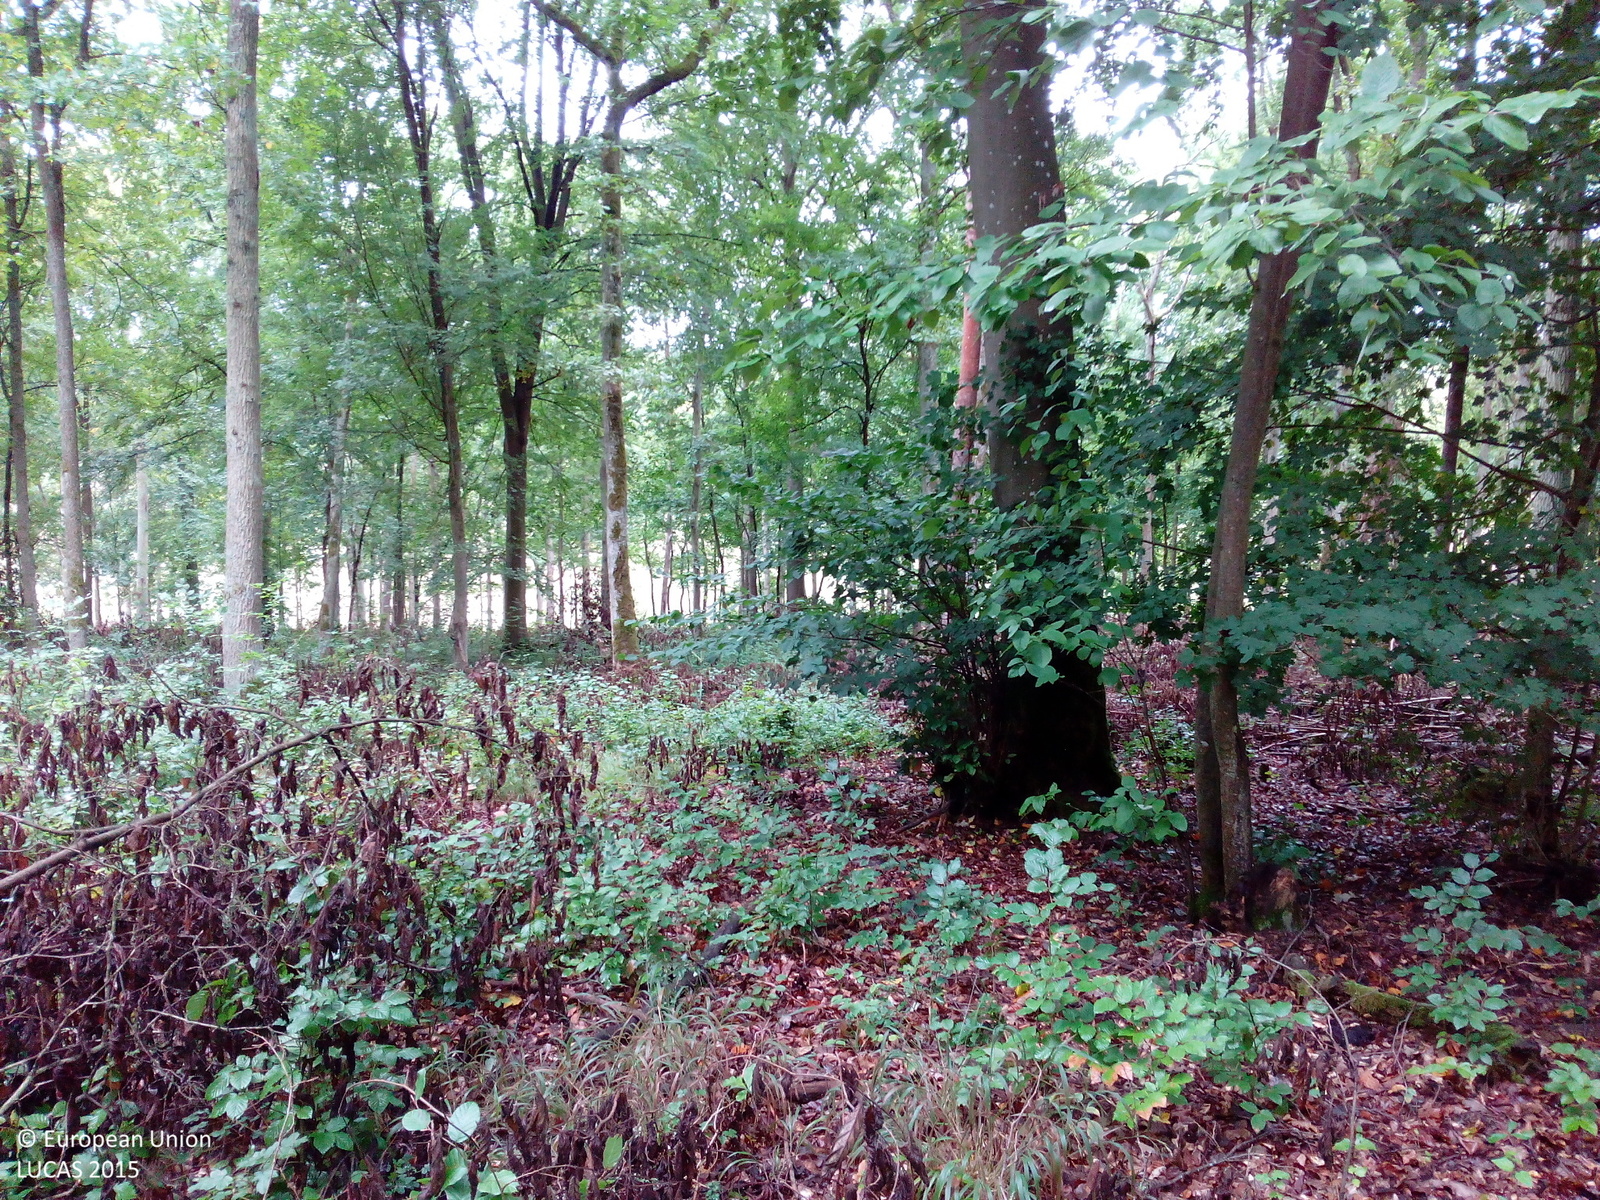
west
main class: Woodland
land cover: Broadleaved woodland
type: mesophytic deciduous forest
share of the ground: > 75 %
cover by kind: broadleaved forest trees 90 %, herbaceous plants 5 %, unconsolidated bare surface 5 %
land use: Forestry
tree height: > 5 m
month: September
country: DE
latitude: 50.0763
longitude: 9.9581
